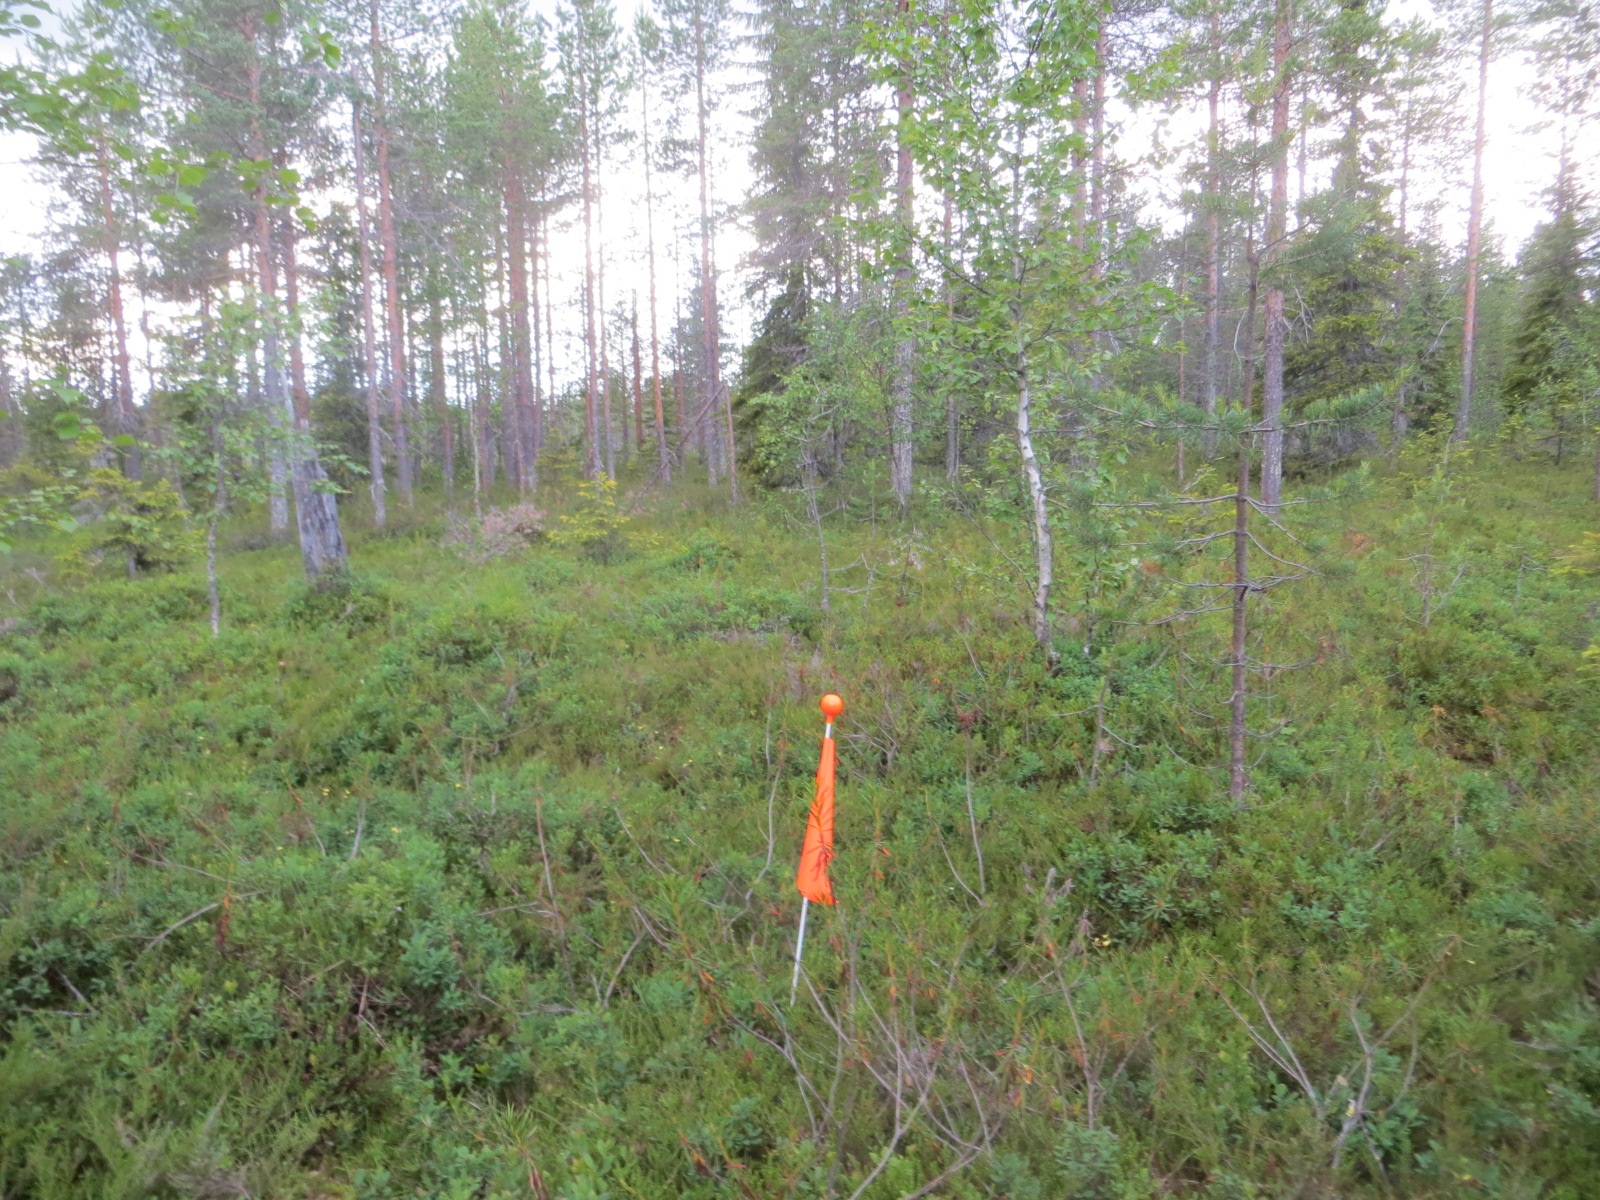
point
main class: Woodland
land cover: Pine dominated mixed woodland
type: boreal forest
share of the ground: 50 - 75 %
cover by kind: shrubs 50 %, coniferous forest trees 25 %, broadleaved forest trees 25 %
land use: Forestry
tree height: > 5 m
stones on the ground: < 10 %
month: July
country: FI
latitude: 66.2737
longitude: 24.5023
